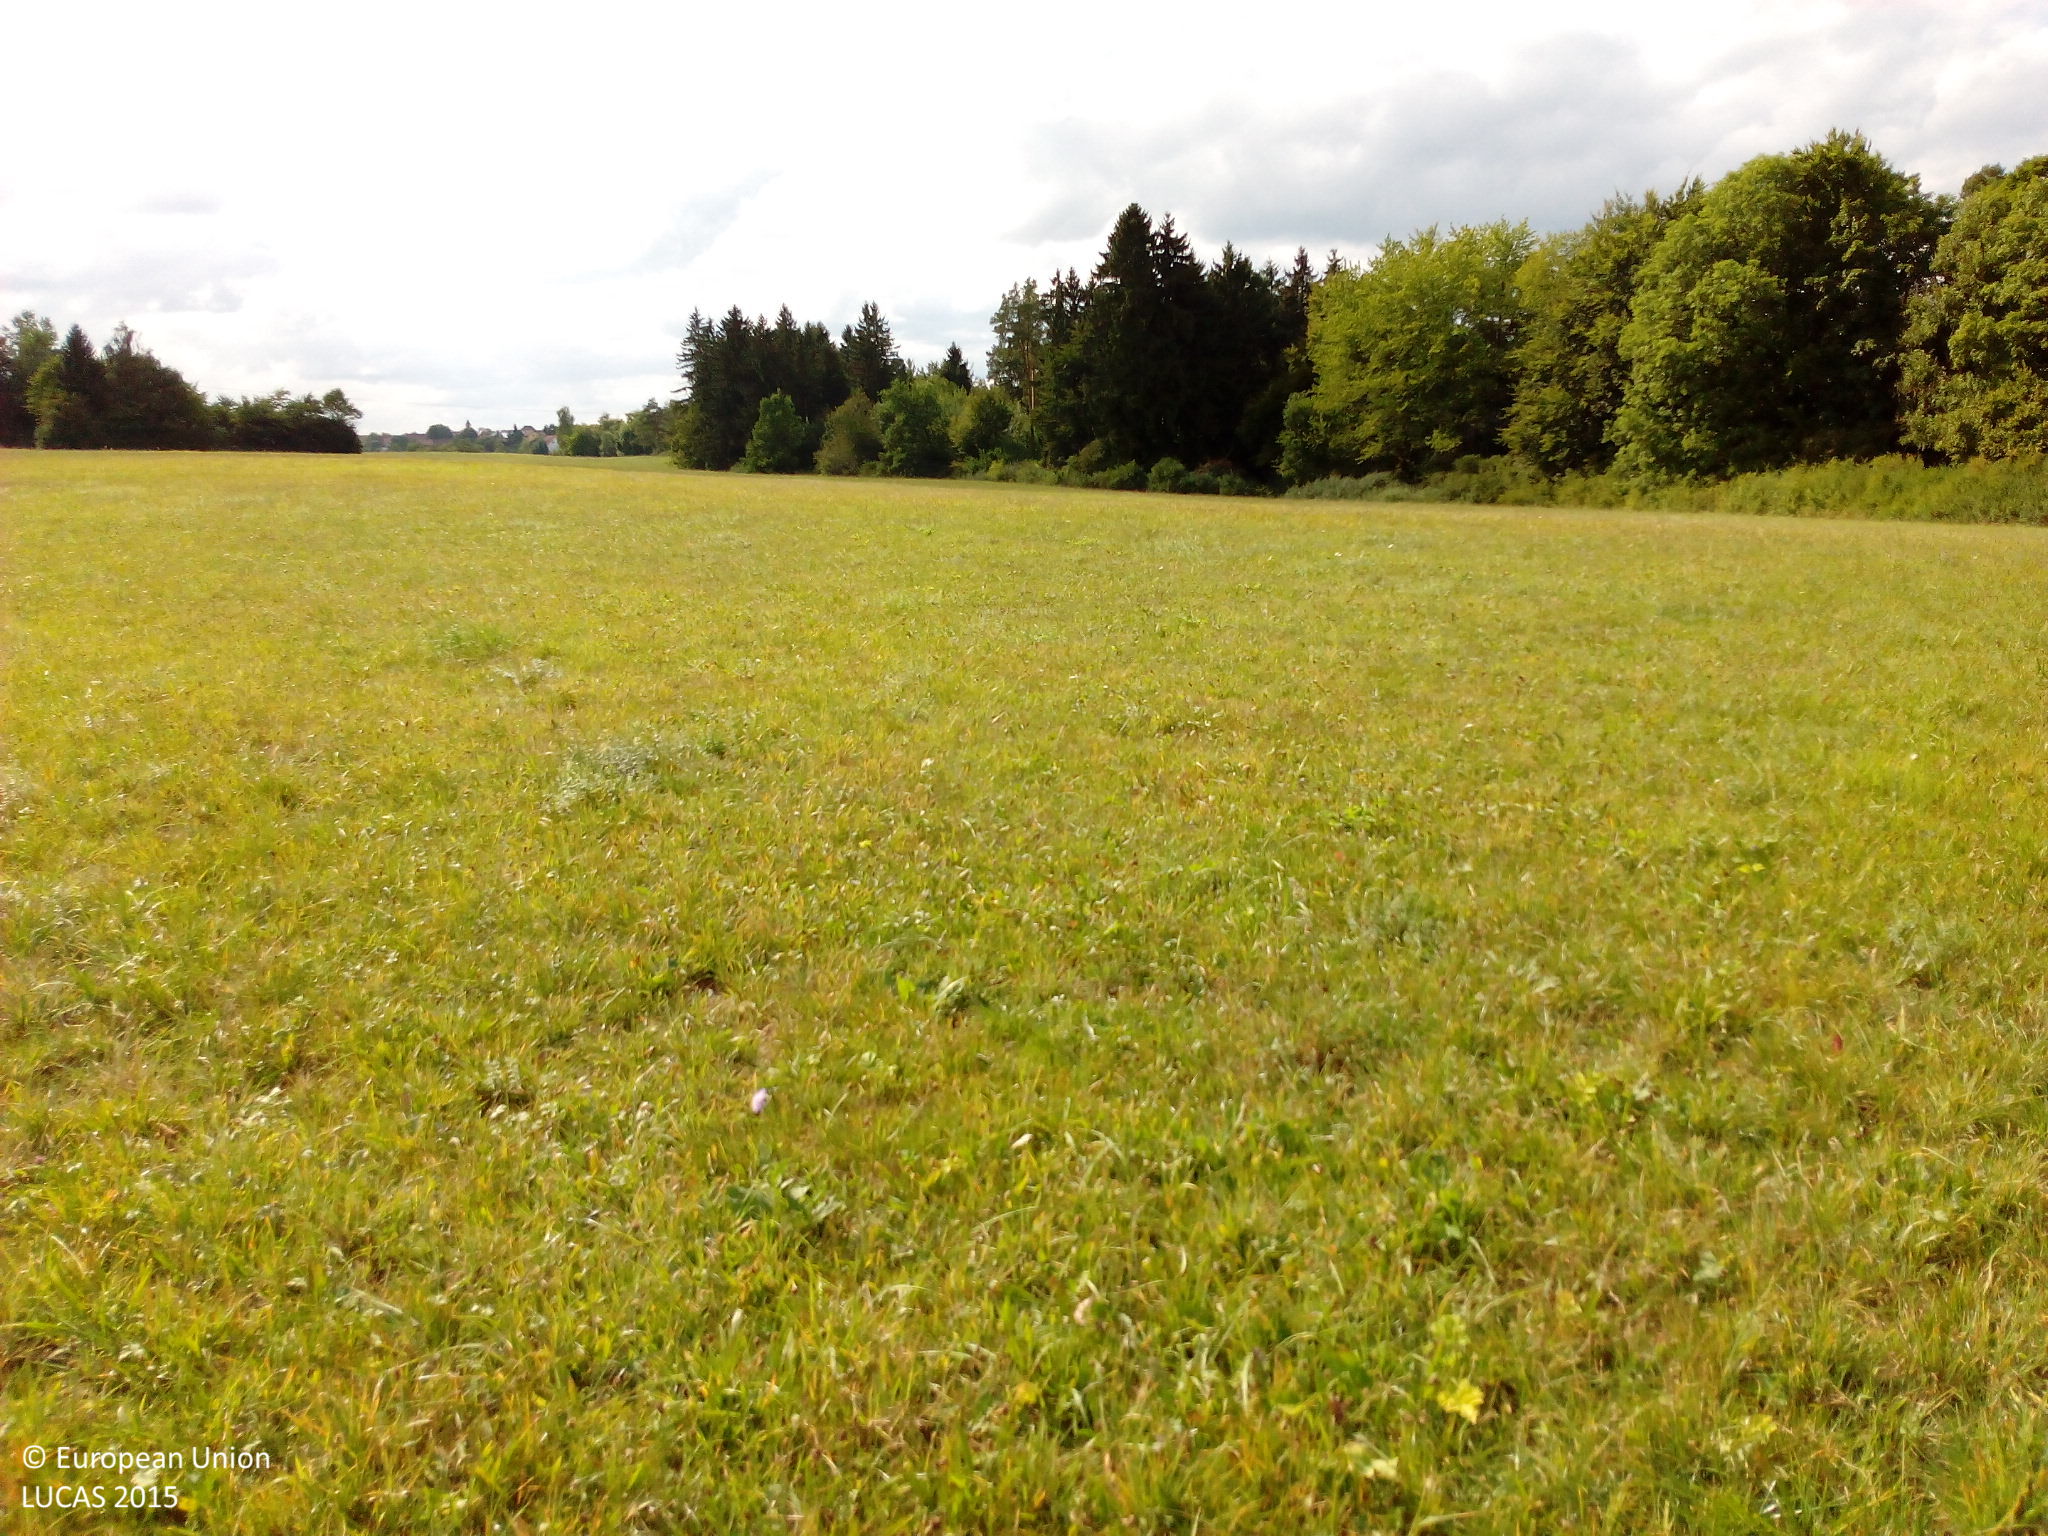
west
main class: Grassland
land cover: Grassland without tree/shrub cover
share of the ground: > 75 %
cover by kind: herbaceous plants 95 %, unconsolidated bare surface 5 %
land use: Agriculture (excluding fallow land and kitchen gardens)
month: September
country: DE
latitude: 48.2861
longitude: 8.5587
